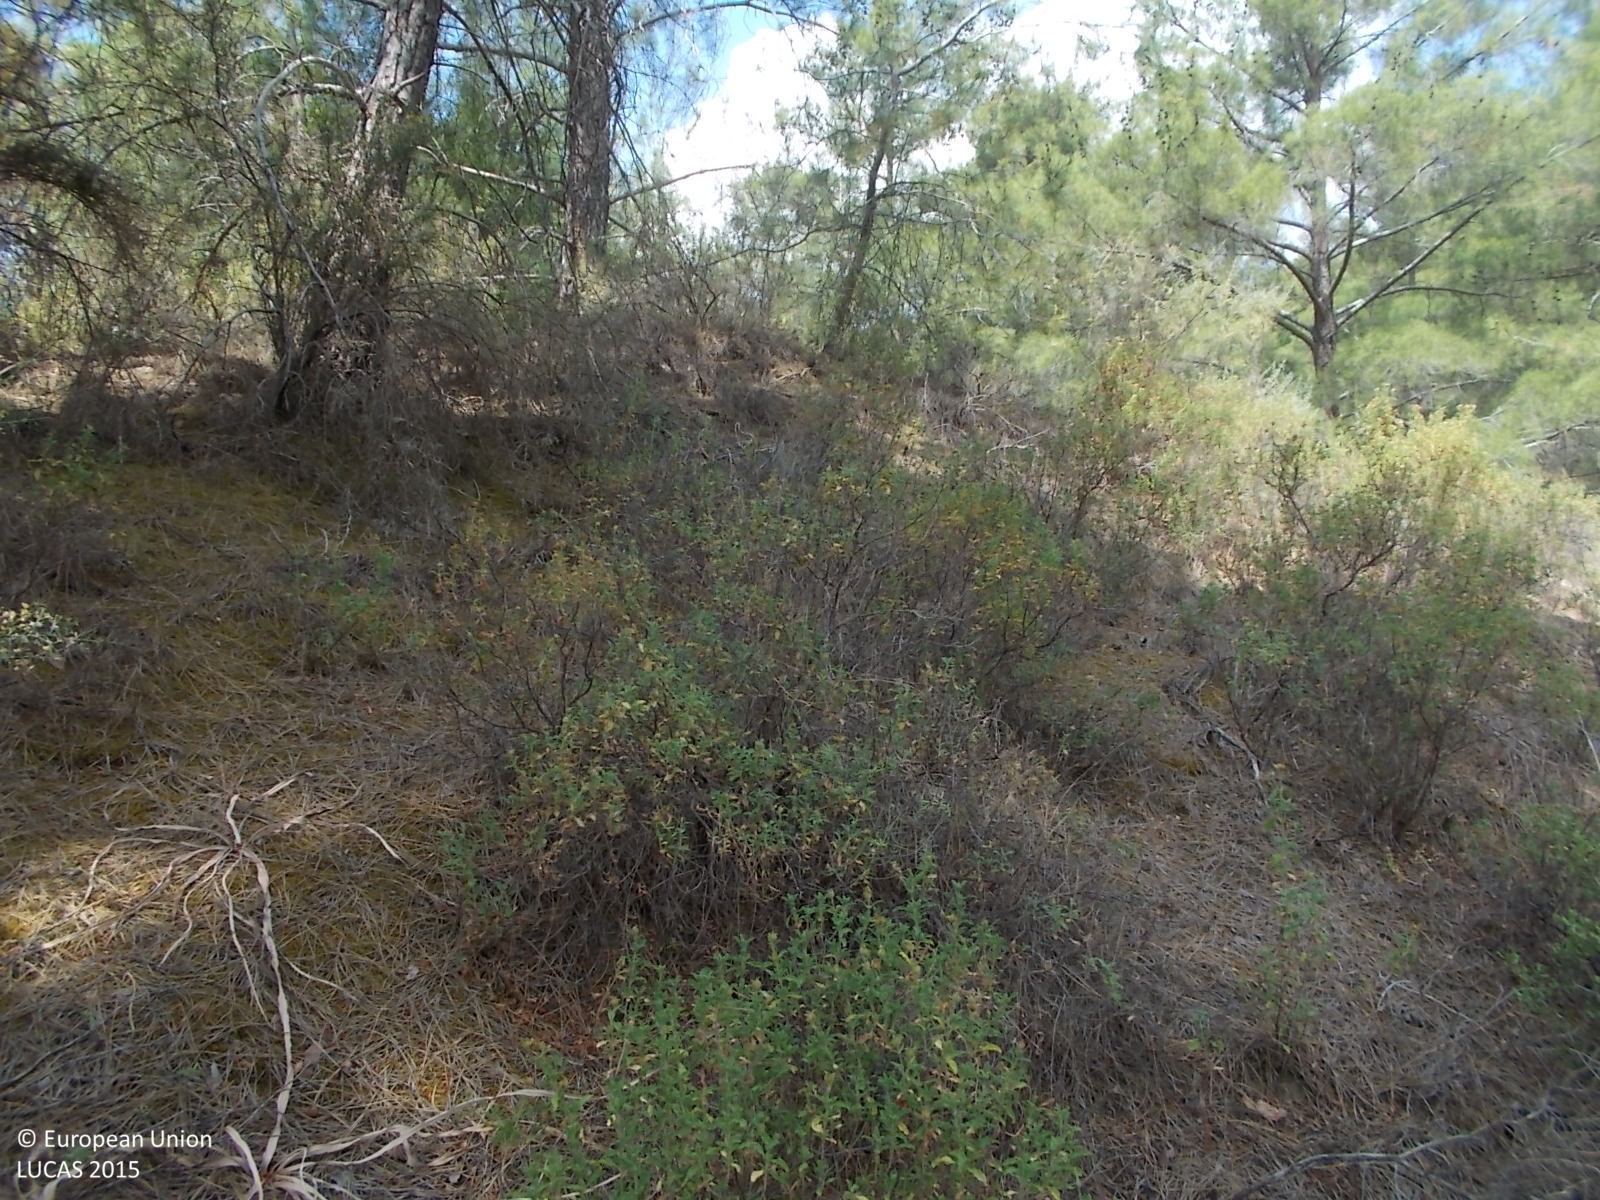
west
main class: Woodland
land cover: Pine dominated coniferous woodland
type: coniferous forest of the mediterranean region
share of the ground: > 75 %
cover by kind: coniferous forest trees 85 %, shrubs 10 %, unconsolidated bare surface 5 %
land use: Forestry
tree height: > 5 m
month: June
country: CY
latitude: 34.8878
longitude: 32.7784
